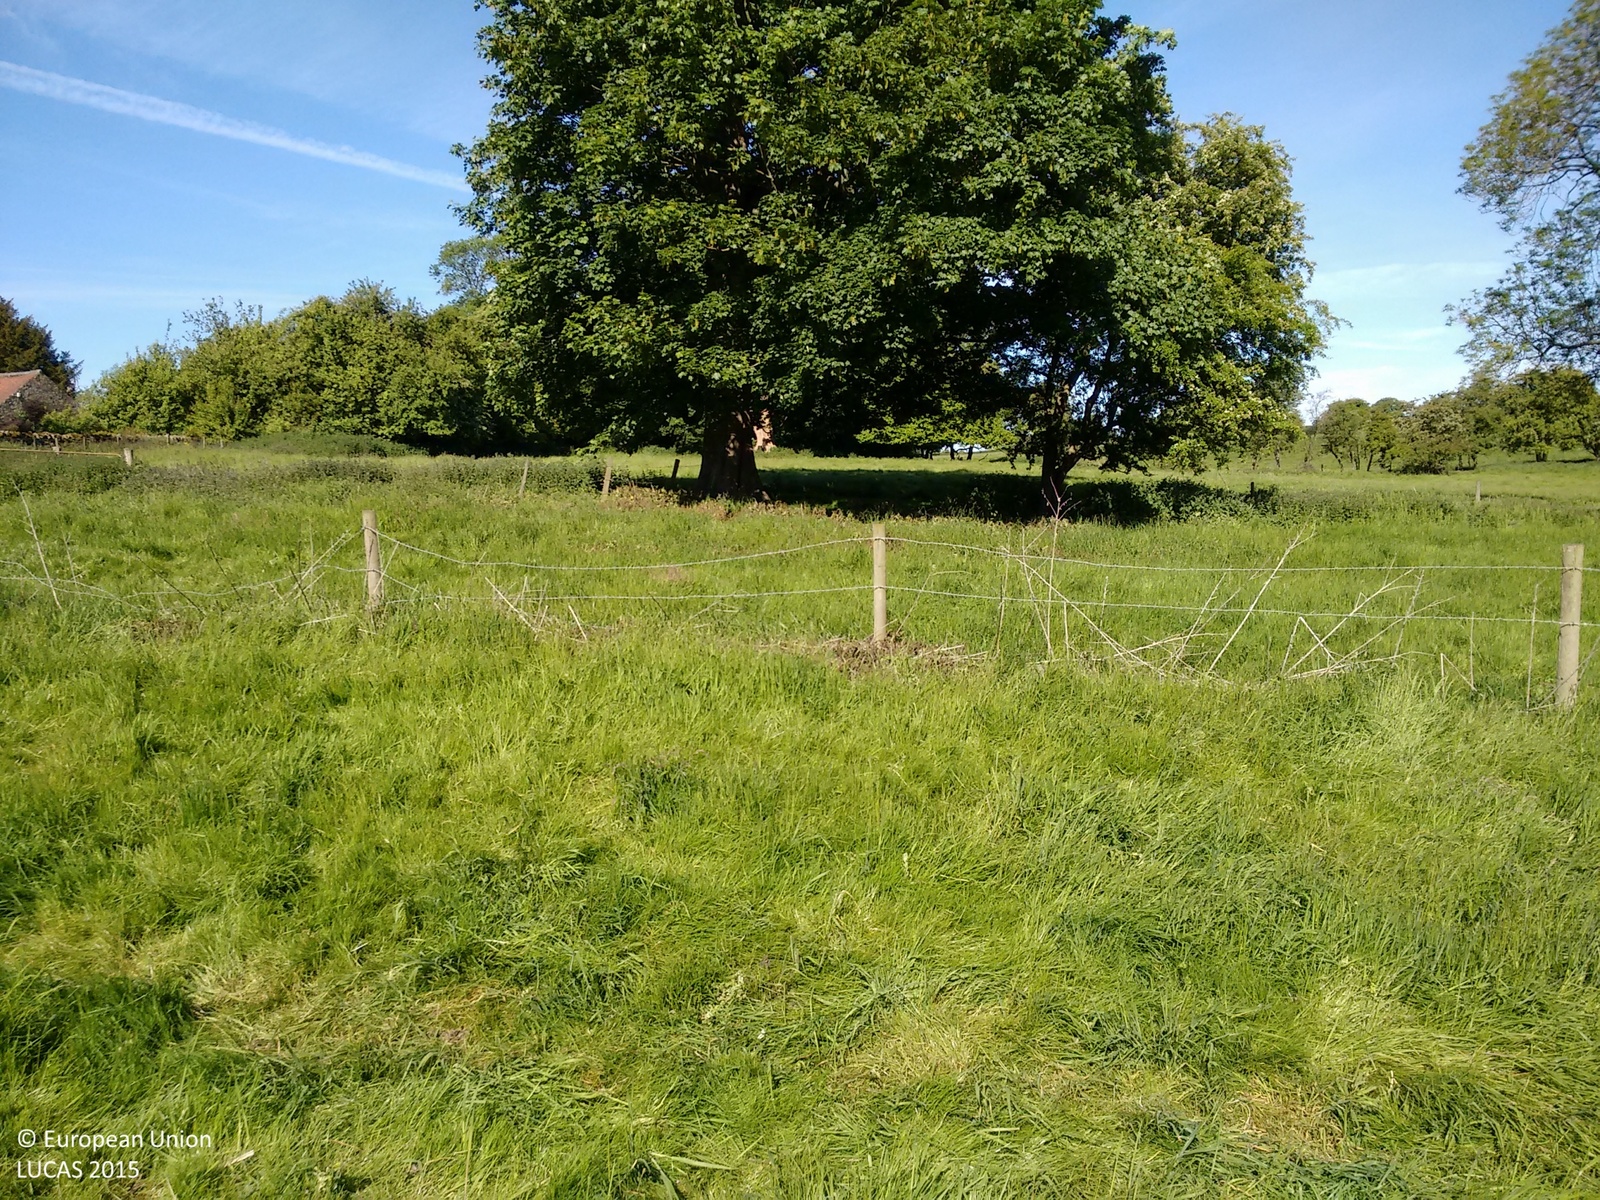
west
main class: Grassland
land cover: Grassland without tree/shrub cover
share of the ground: > 75 %
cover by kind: herbaceous plants 100 %
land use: Agriculture (excluding fallow land and kitchen gardens)
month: June
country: GB
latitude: 54.1893
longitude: -1.1862
